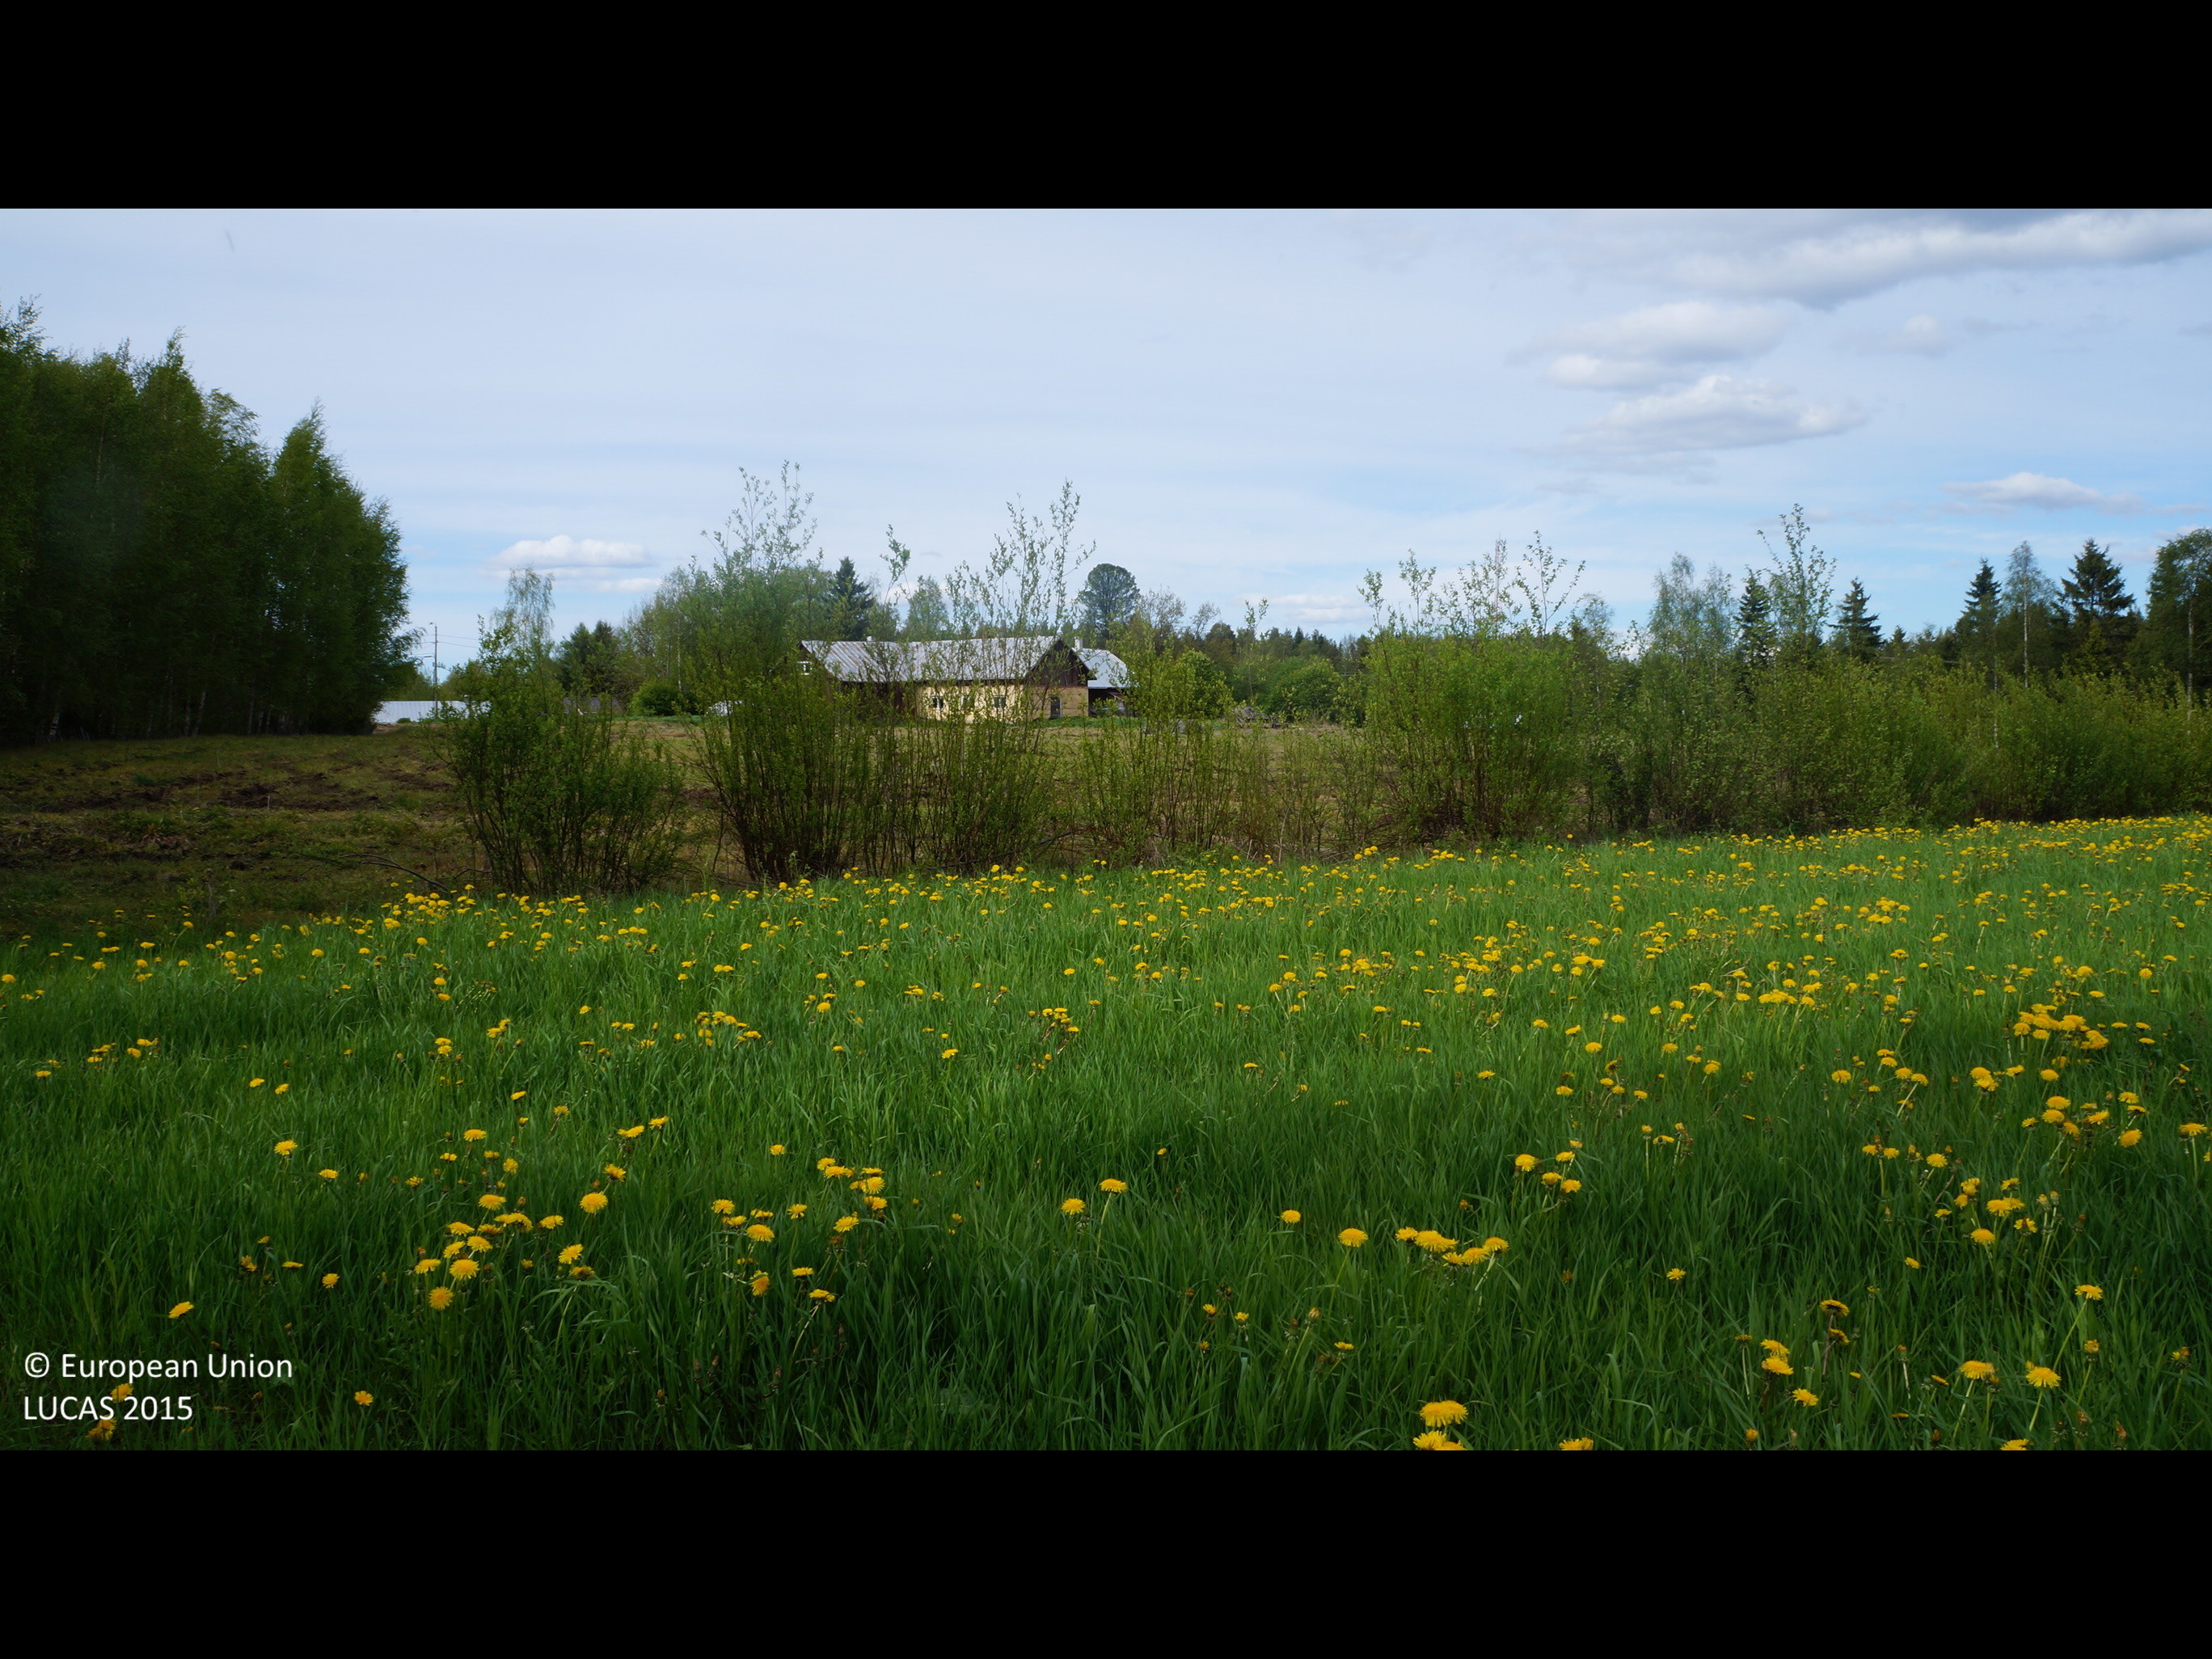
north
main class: Cropland
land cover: Temporary grasslands
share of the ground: > 75 %
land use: Agriculture (excluding fallow land and kitchen gardens)
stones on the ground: < 10 %
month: June
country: FI
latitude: 63.7059
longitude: 23.3099
